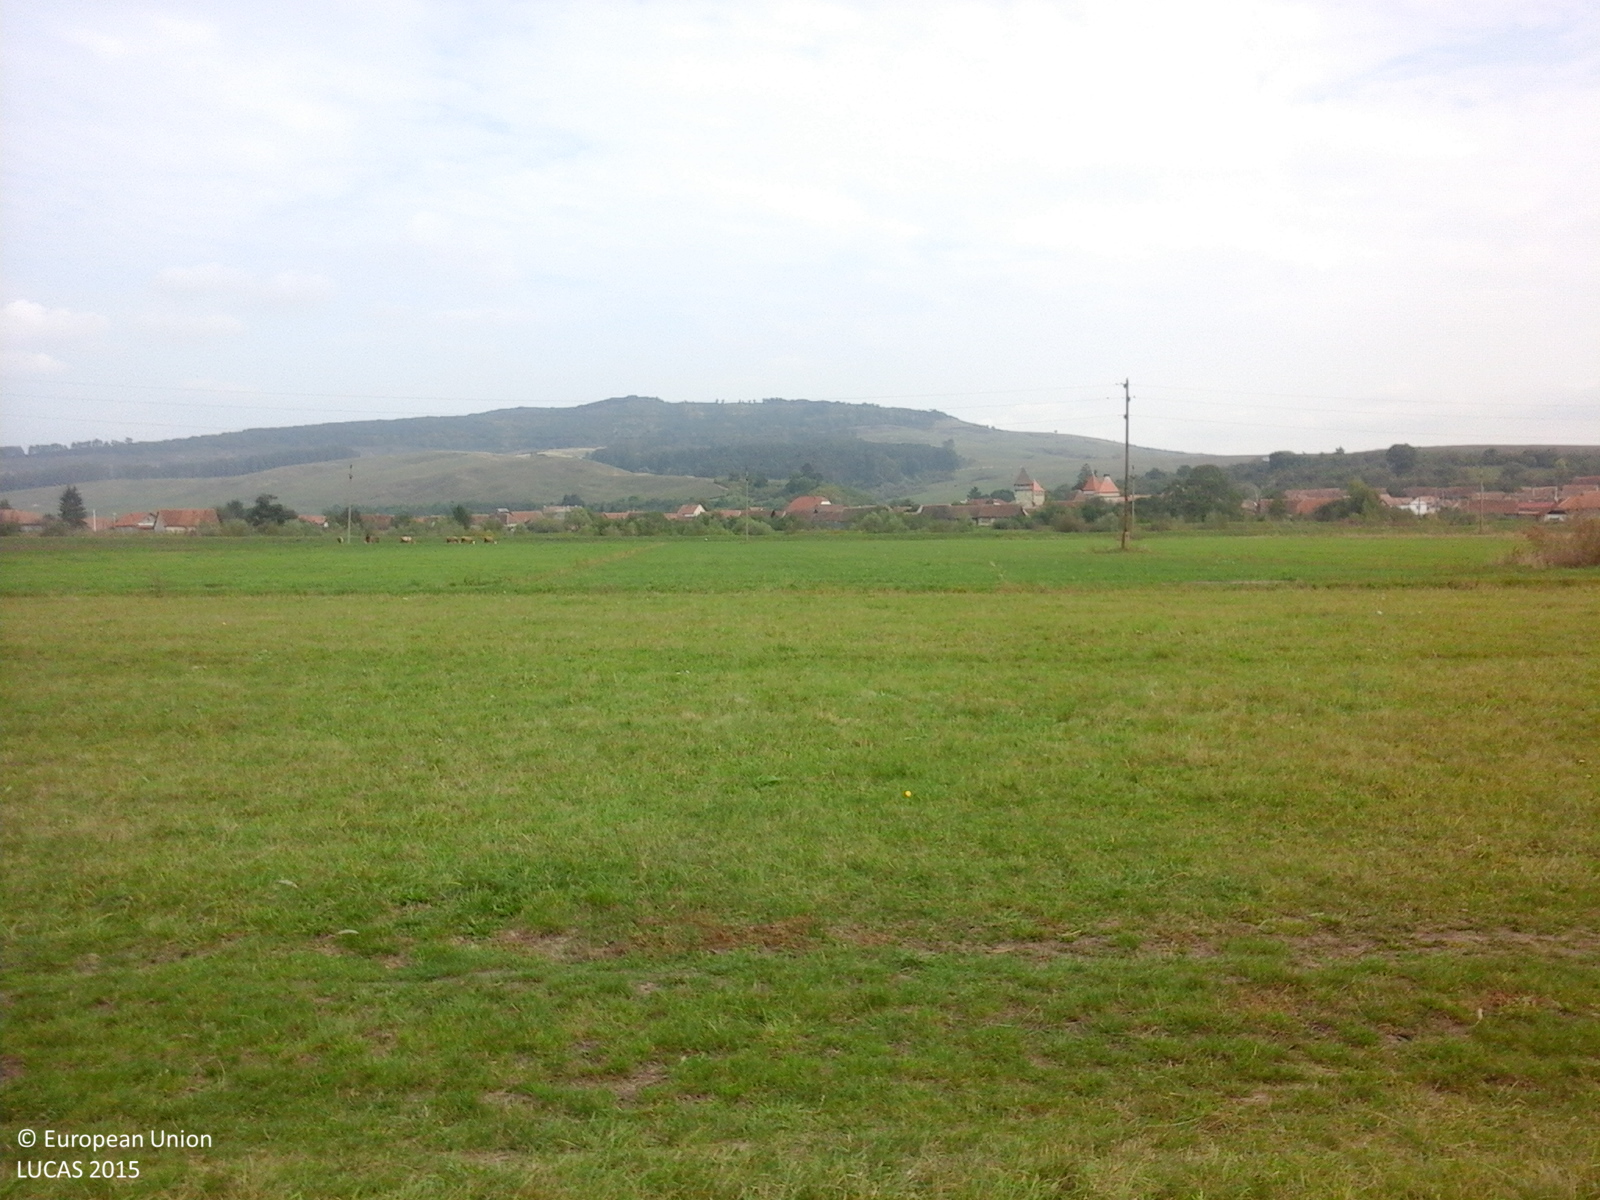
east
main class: Grassland
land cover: Grassland without tree/shrub cover
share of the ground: > 75 %
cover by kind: herbaceous plants 100 %
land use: Agriculture (excluding fallow land and kitchen gardens)
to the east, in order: Grassland without tree/shrub cover; Tracks; Grassland without tree/shrub cover; Ditches and canals; Grass margins; Tracks; Lucerne; Electric lines; Lucerne; Electric lines; Lucerne
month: October
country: RO
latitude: 46.0892
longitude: 25.2711
